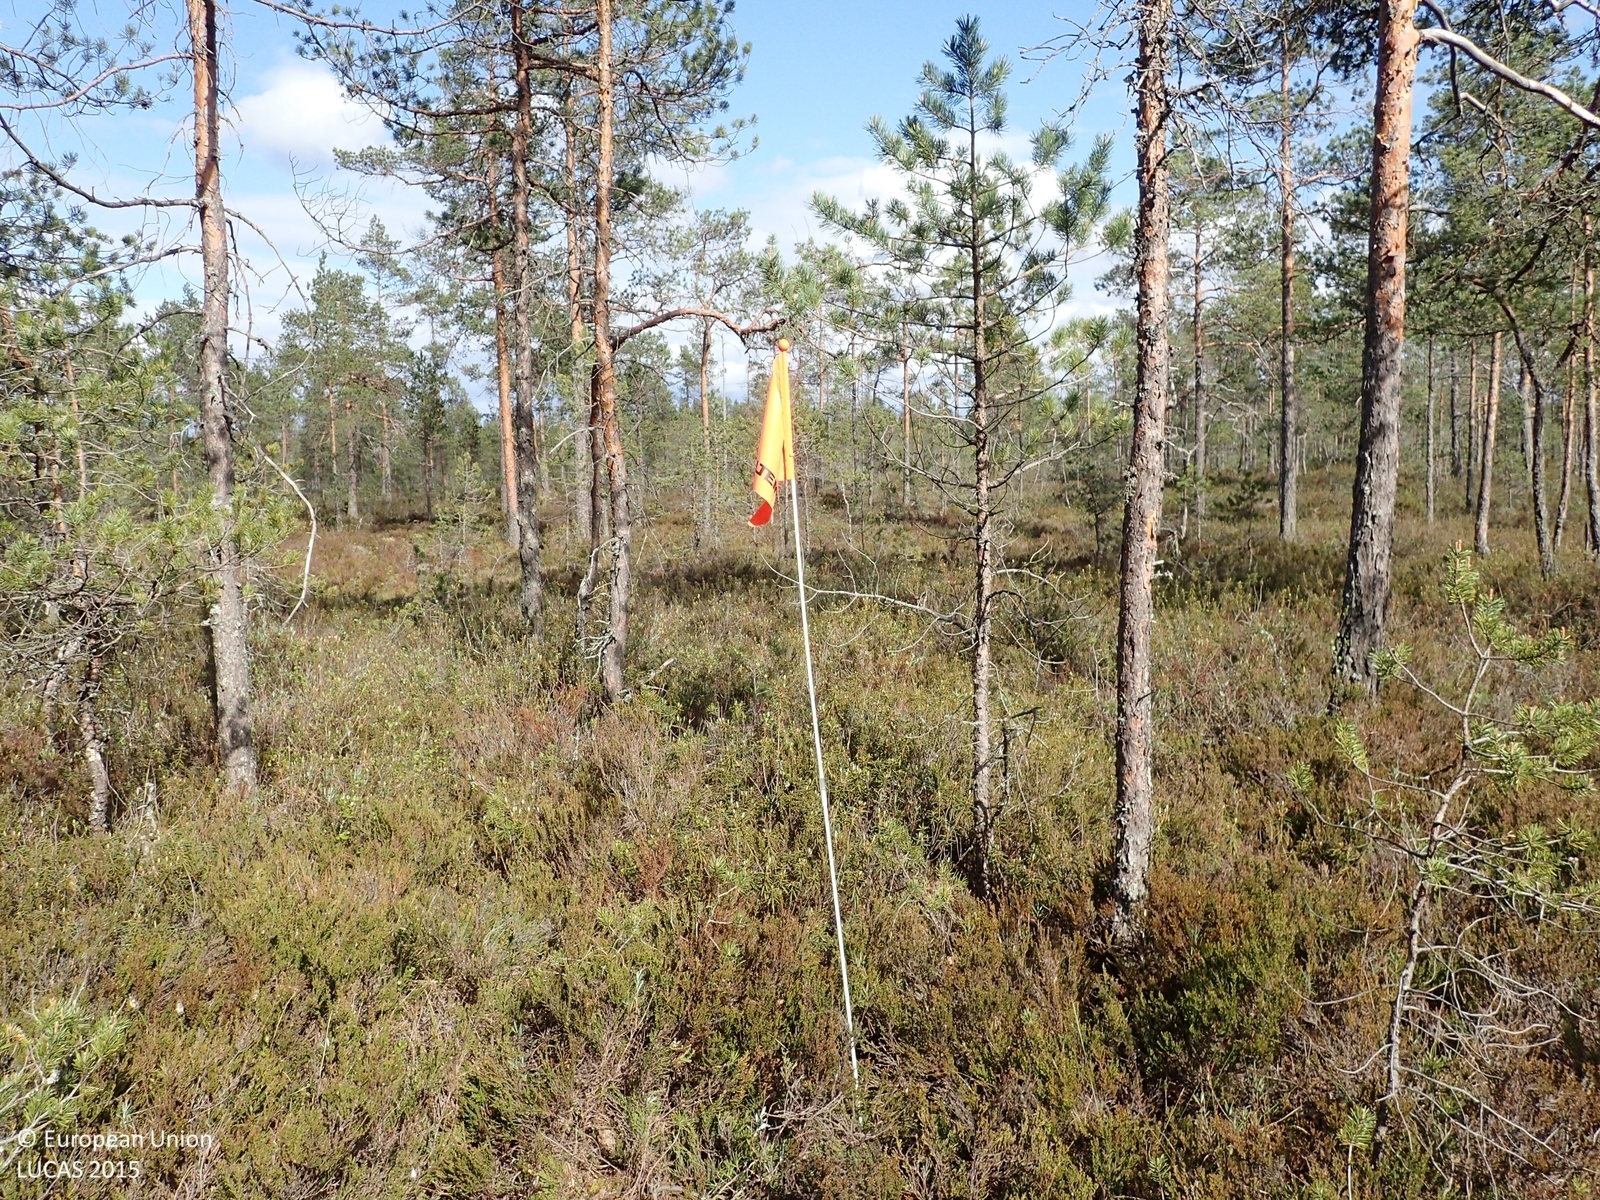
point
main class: Woodland
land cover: Pine dominated coniferous woodland
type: mire and swamp forests
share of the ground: 50 - 75 %
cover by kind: coniferous forest trees 50 %, shrubs 50 %
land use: Semi-natural and natural areas not in use
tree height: > 5 m
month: June
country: FI
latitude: 62.2729
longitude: 21.8204
